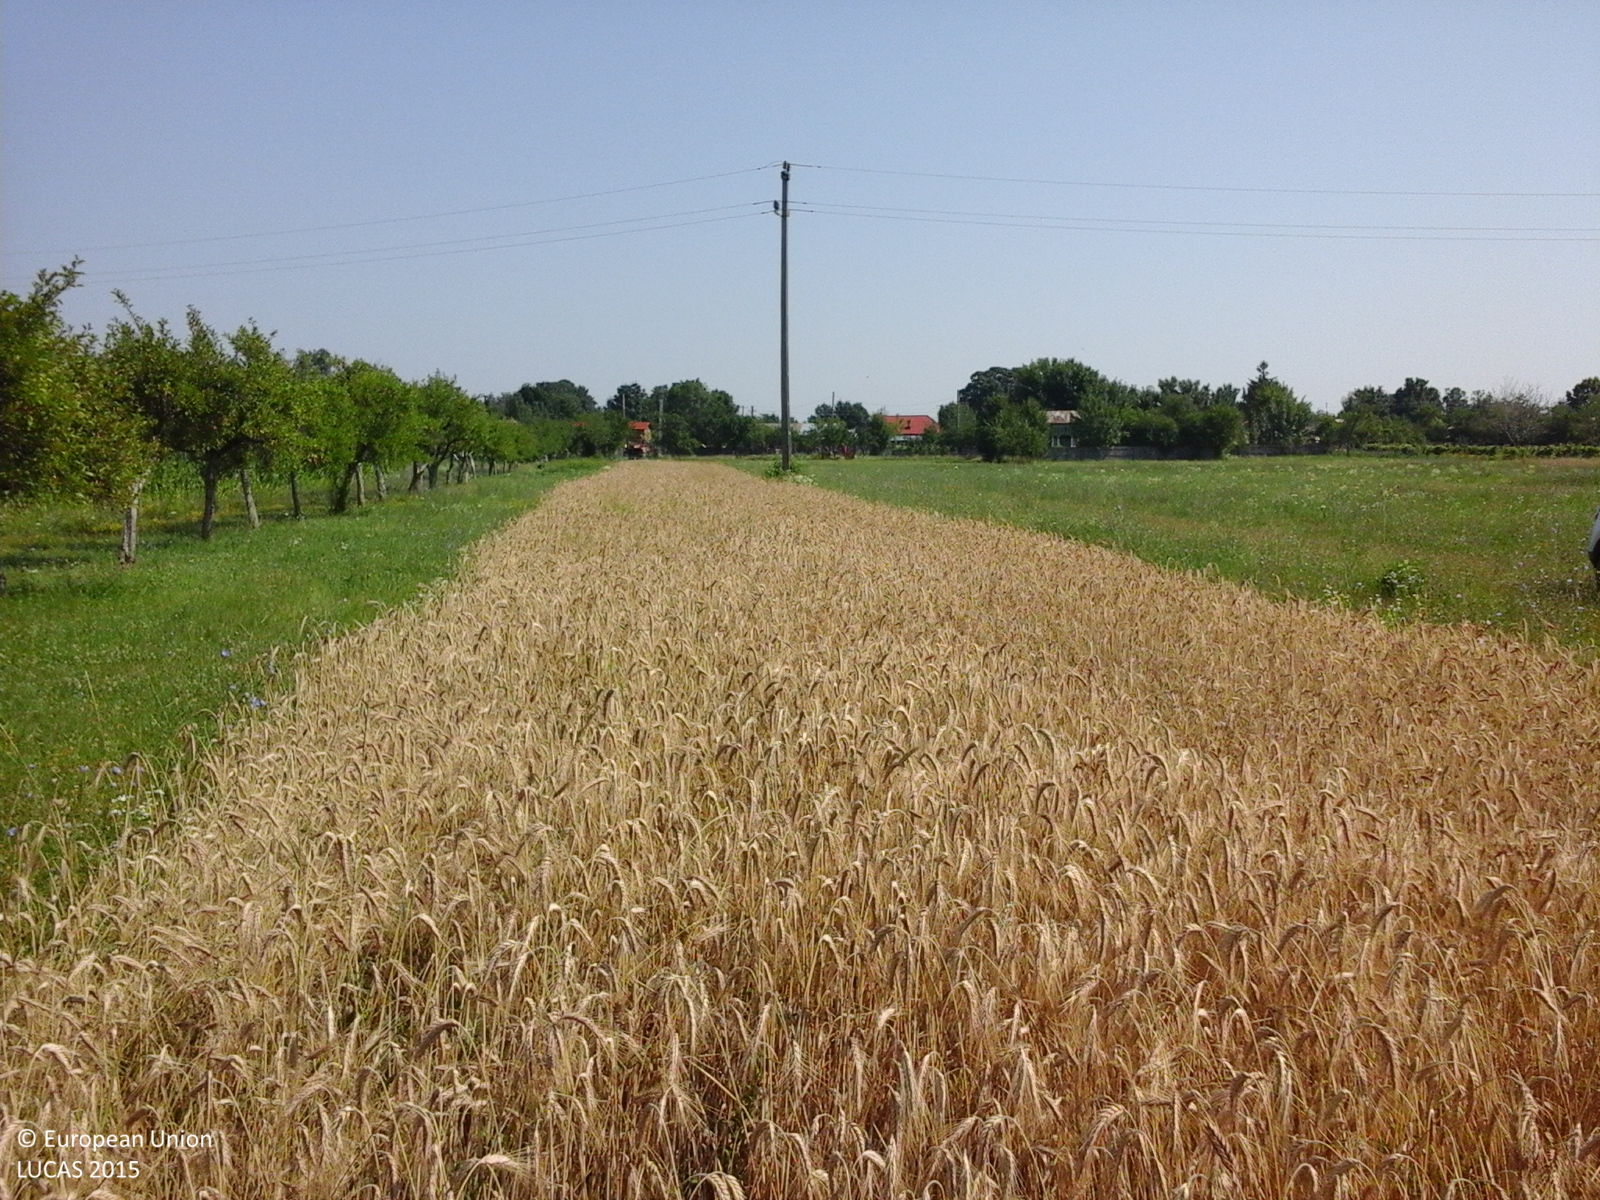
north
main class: Cropland
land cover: Common wheat
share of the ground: > 75 %
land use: Agriculture (excluding fallow land and kitchen gardens)
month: July
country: RO
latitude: 44.4904
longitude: 24.9305
